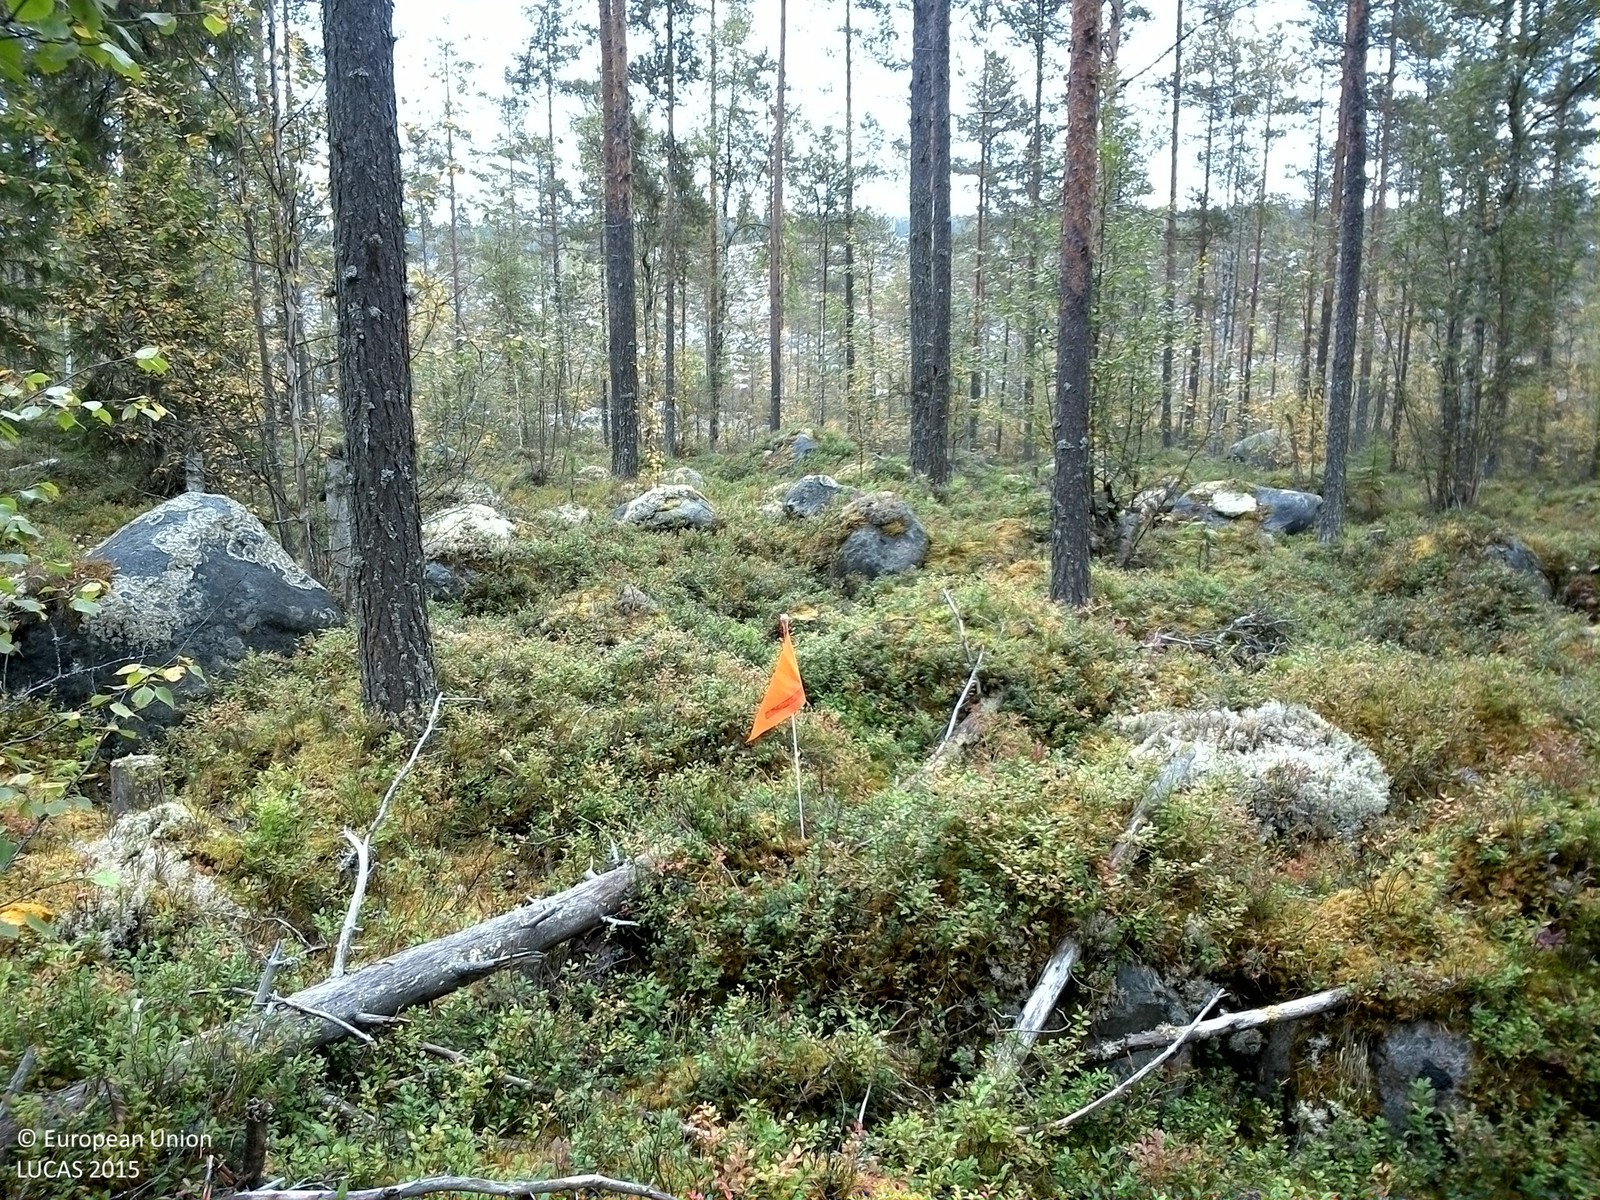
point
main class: Woodland
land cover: Pine dominated mixed woodland
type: boreal forest
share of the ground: 50 - 75 %
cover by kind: coniferous forest trees 40 %, shrubs 25 %, broadleaved forest trees 20 %, lichens and mosses 10 %, consolidated bare surface 5 %
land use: Forestry
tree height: > 5 m
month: September
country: SE
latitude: 61.6602
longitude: 15.0635
